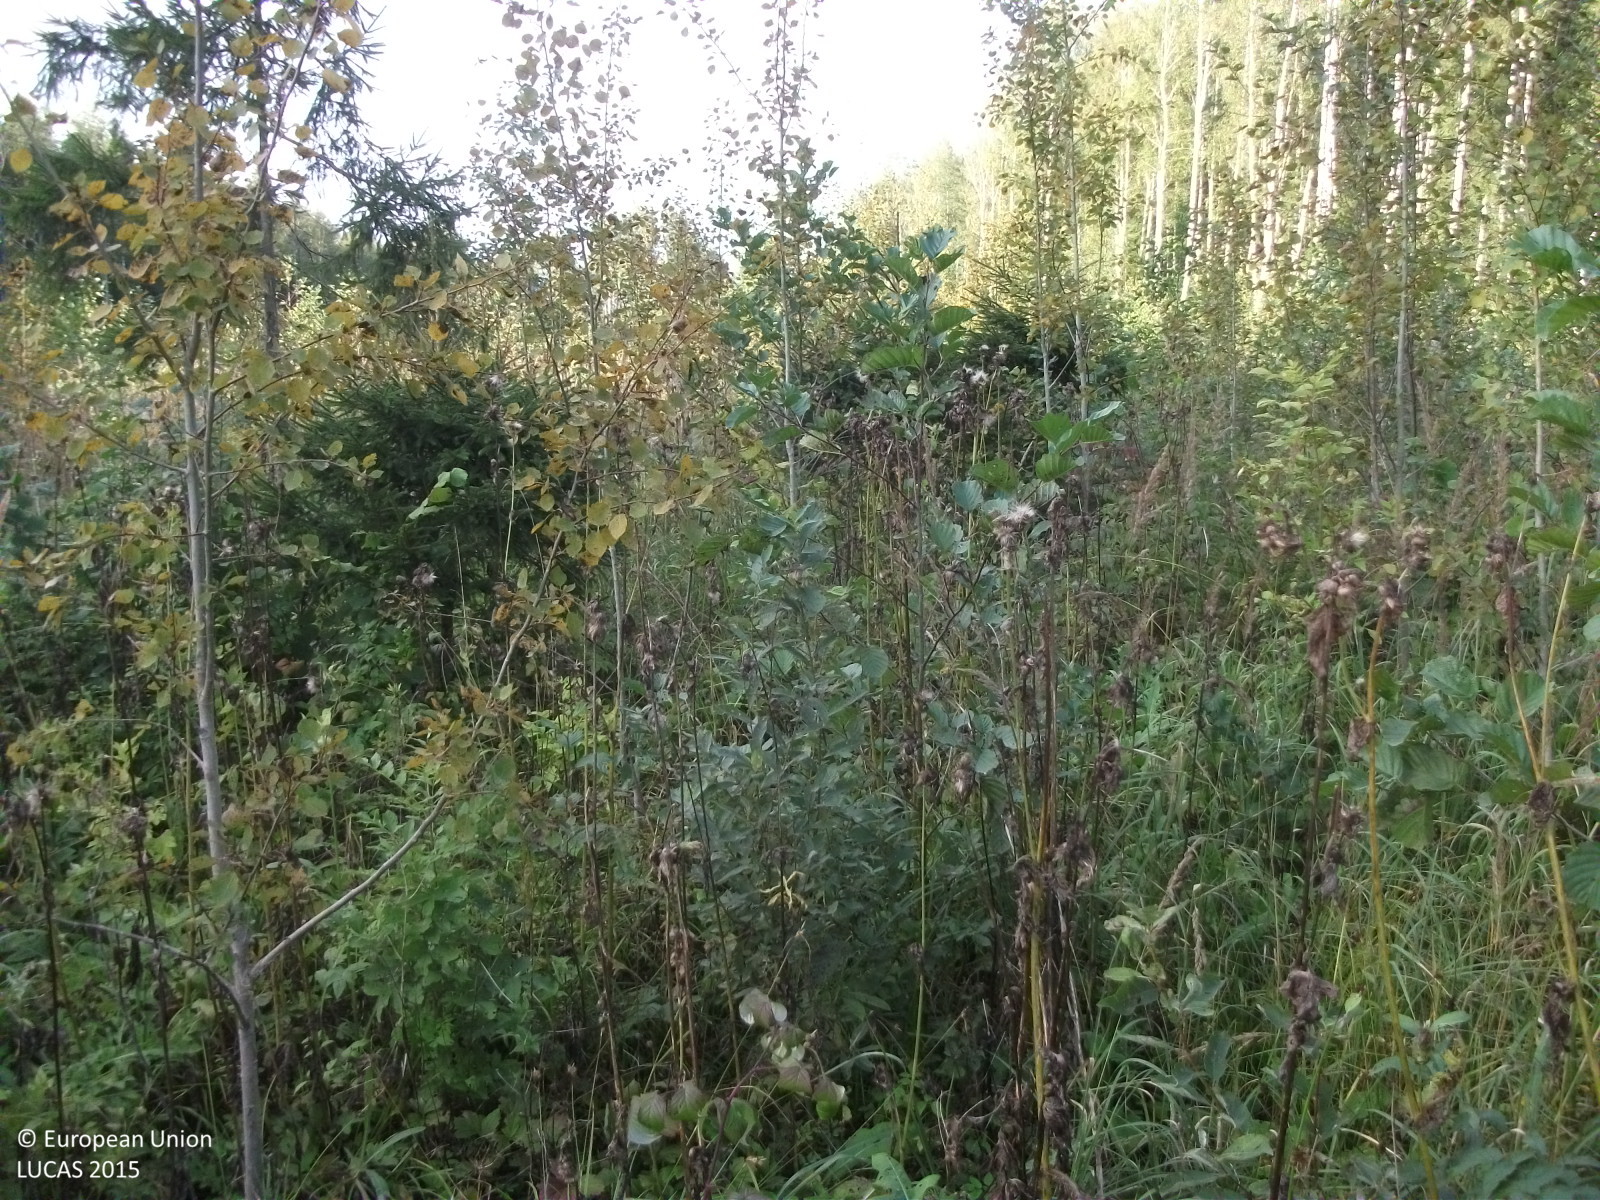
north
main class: Woodland
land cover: Broadleaved woodland
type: non-riverine alder, birch or aspen forest
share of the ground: 50 - 75 %
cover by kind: broadleaved forest trees 50 %, shrubs 35 %, herbaceous plants 10 %, coniferous forest trees 5 %
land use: Forestry
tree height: < 5 m
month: September
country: LV
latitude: 57.6065
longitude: 24.5344
